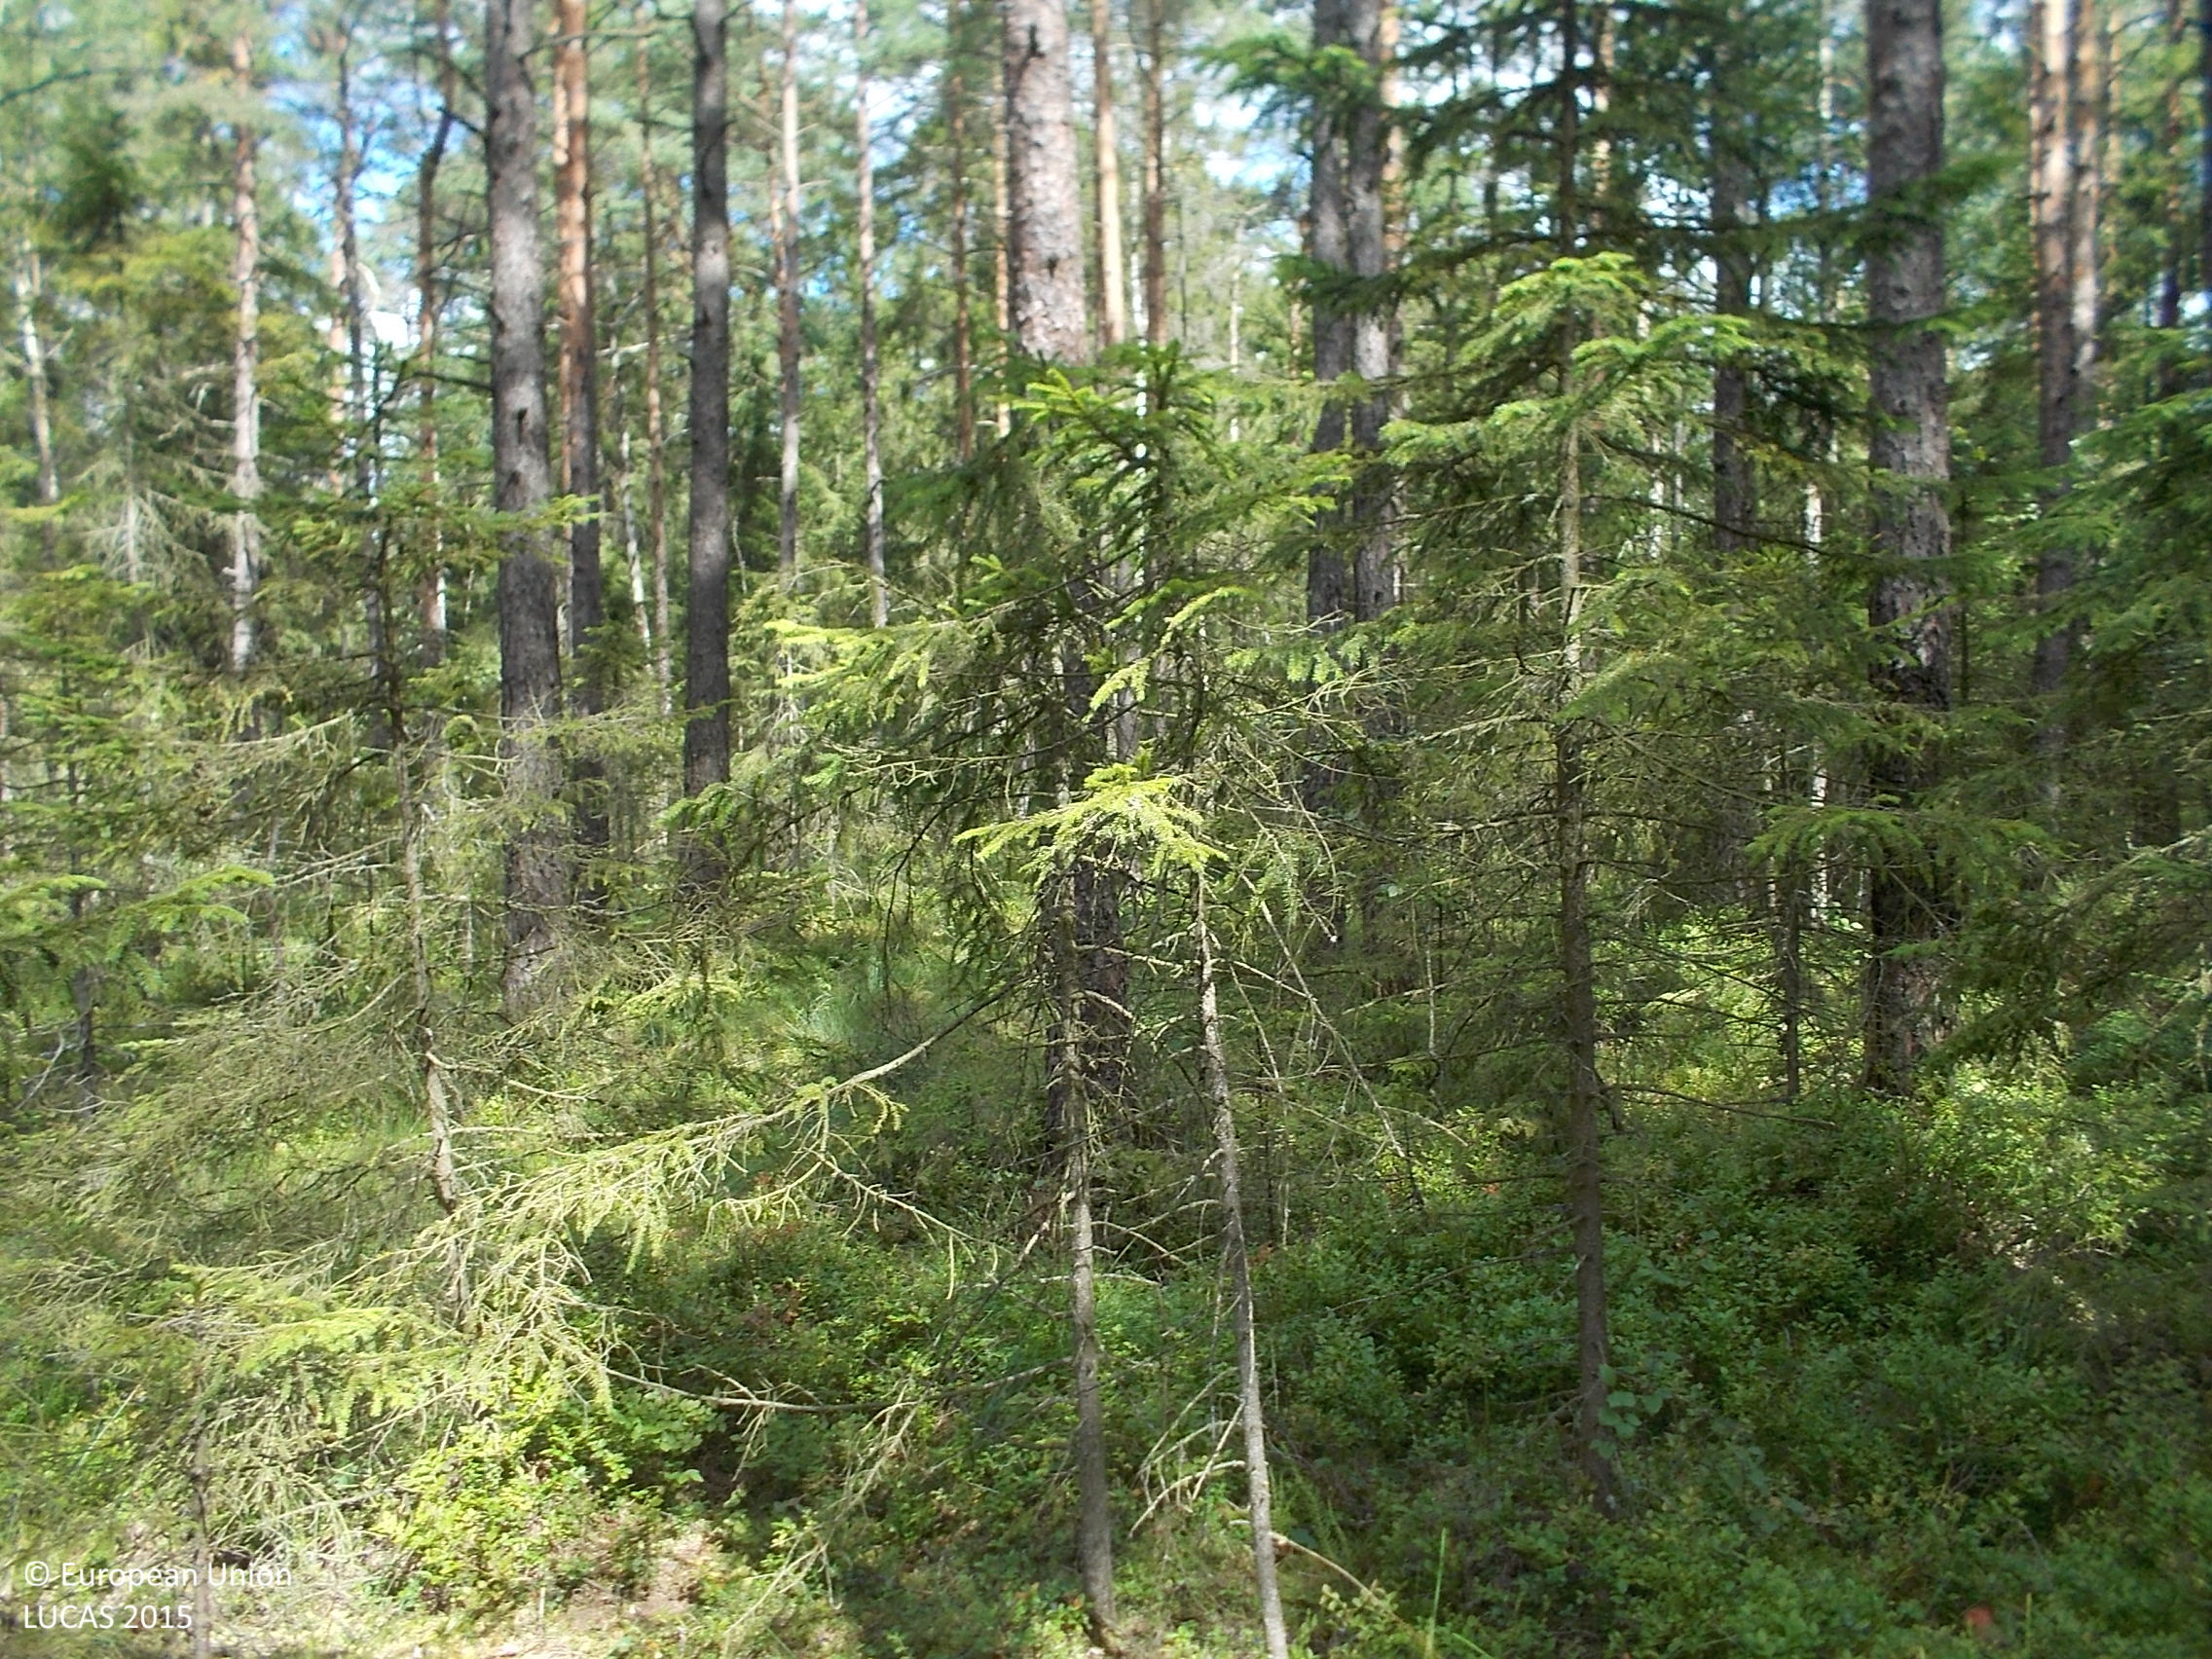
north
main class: Woodland
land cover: Pine dominated coniferous woodland
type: boreal forest
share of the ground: > 75 %
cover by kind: coniferous forest trees 85 %, shrubs 10 %, herbaceous plants 5 %
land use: Forestry
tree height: > 5 m
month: August
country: SE
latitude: 57.5883
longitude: 12.2881
